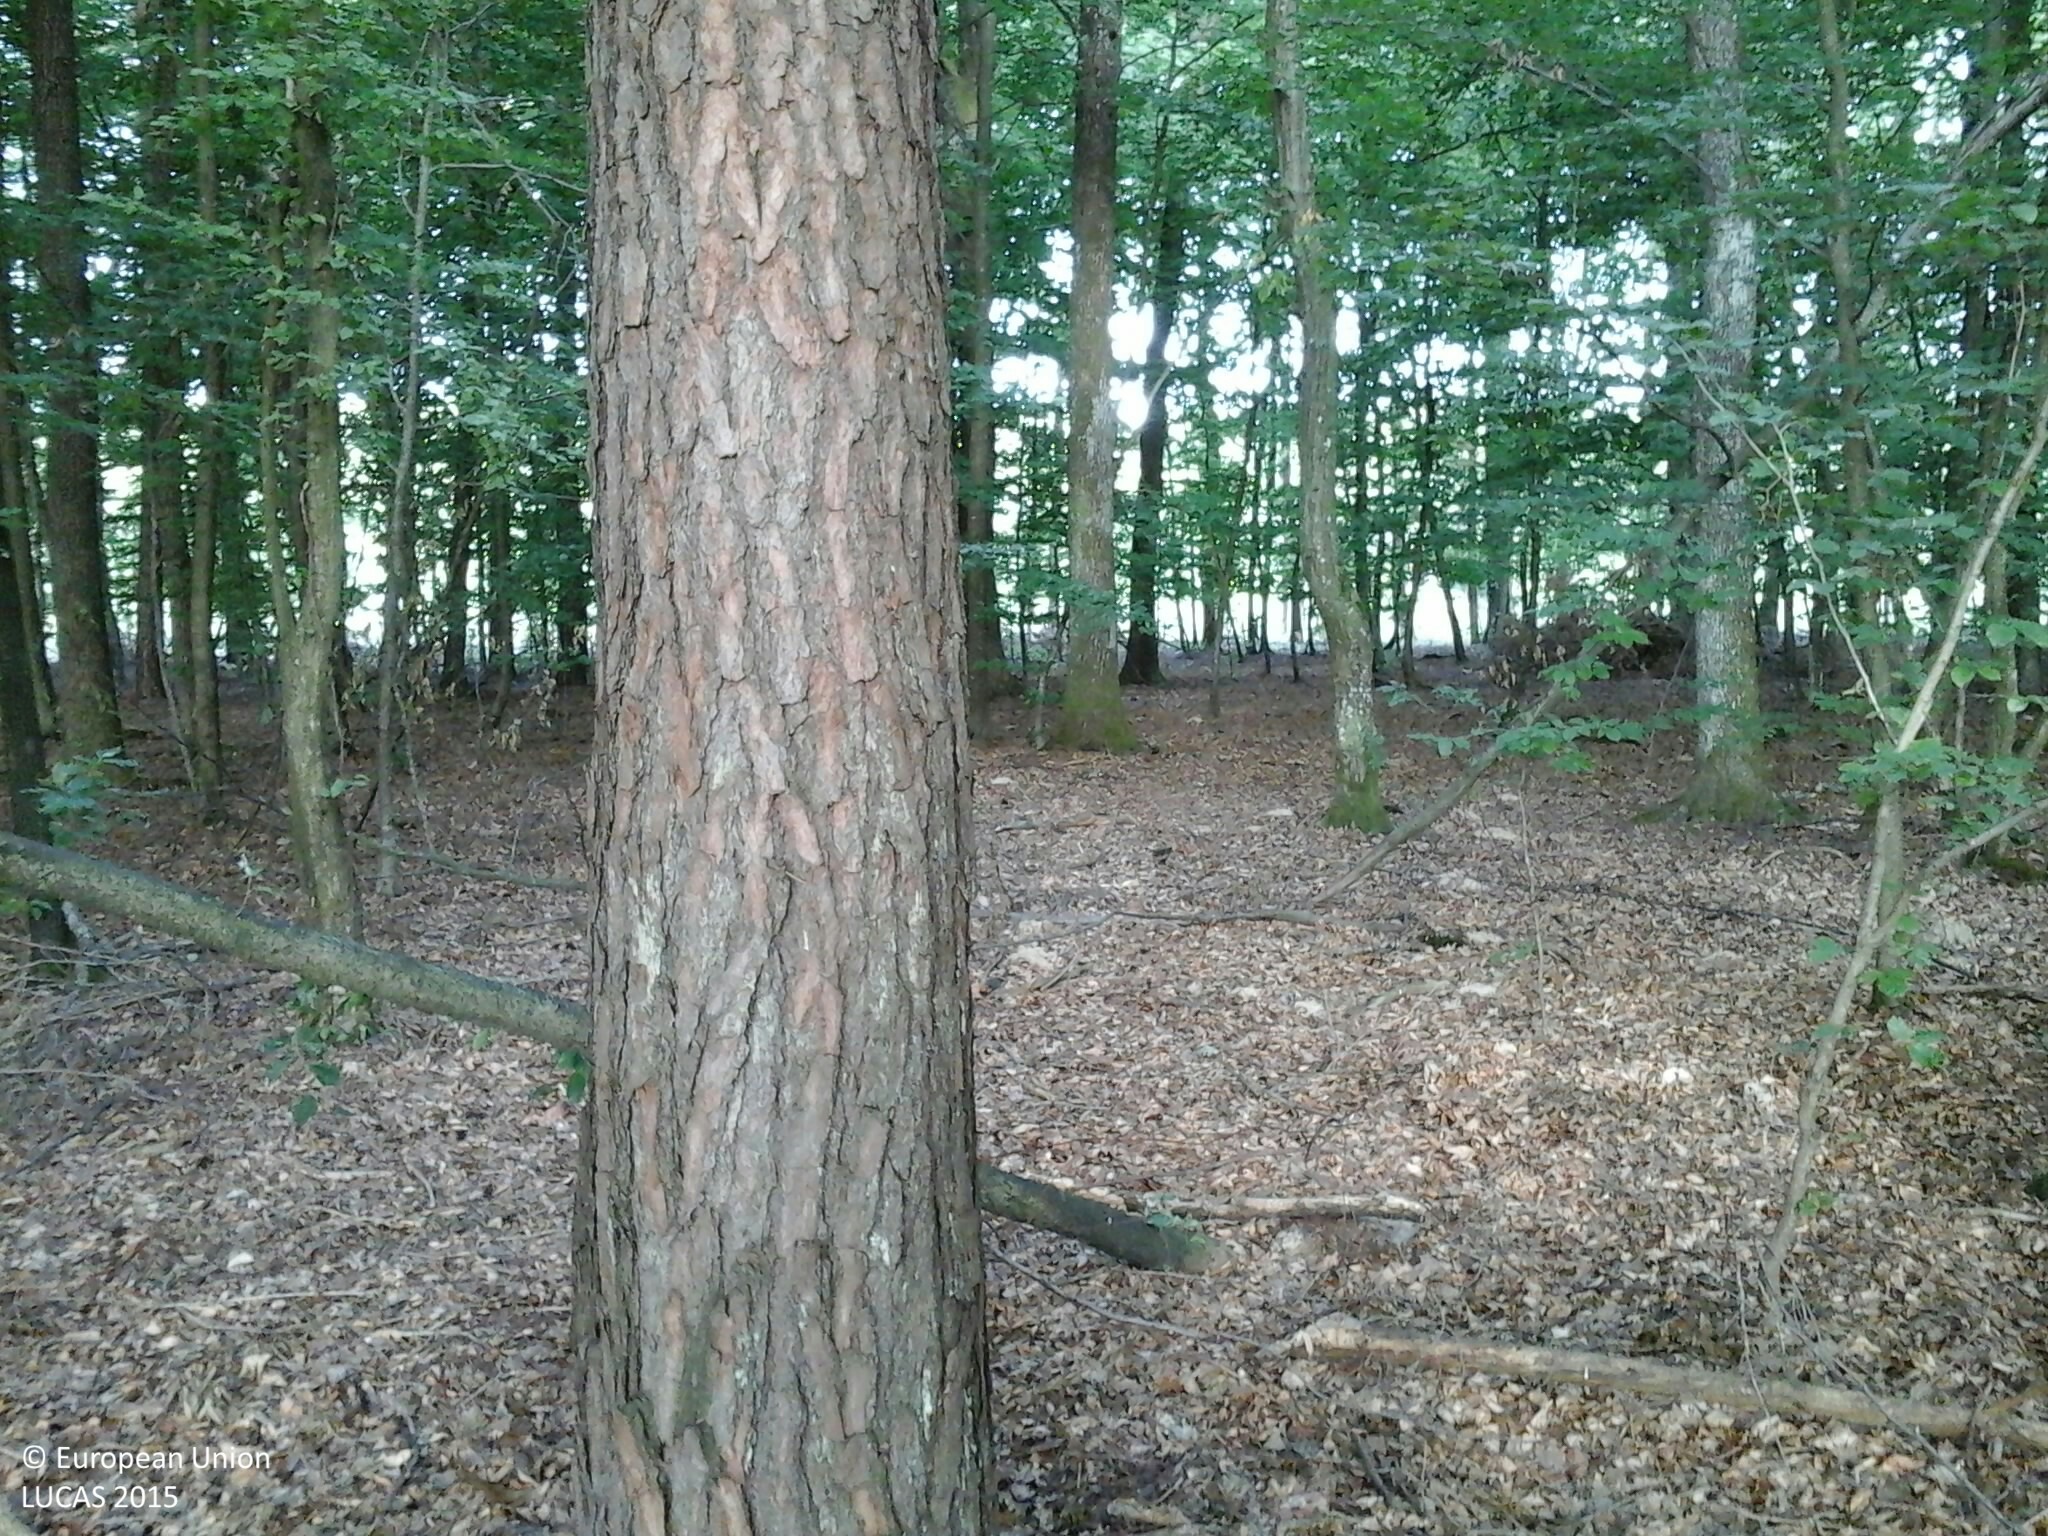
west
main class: Woodland
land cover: Broadleaved woodland
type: mesophytic deciduous forest
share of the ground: > 75 %
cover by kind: broadleaved forest trees 70 %, coniferous forest trees 20 %, shrubs 5 %, herbaceous plants 5 %
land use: Forestry
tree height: > 5 m
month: July
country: HU
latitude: 46.8794
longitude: 16.4447
